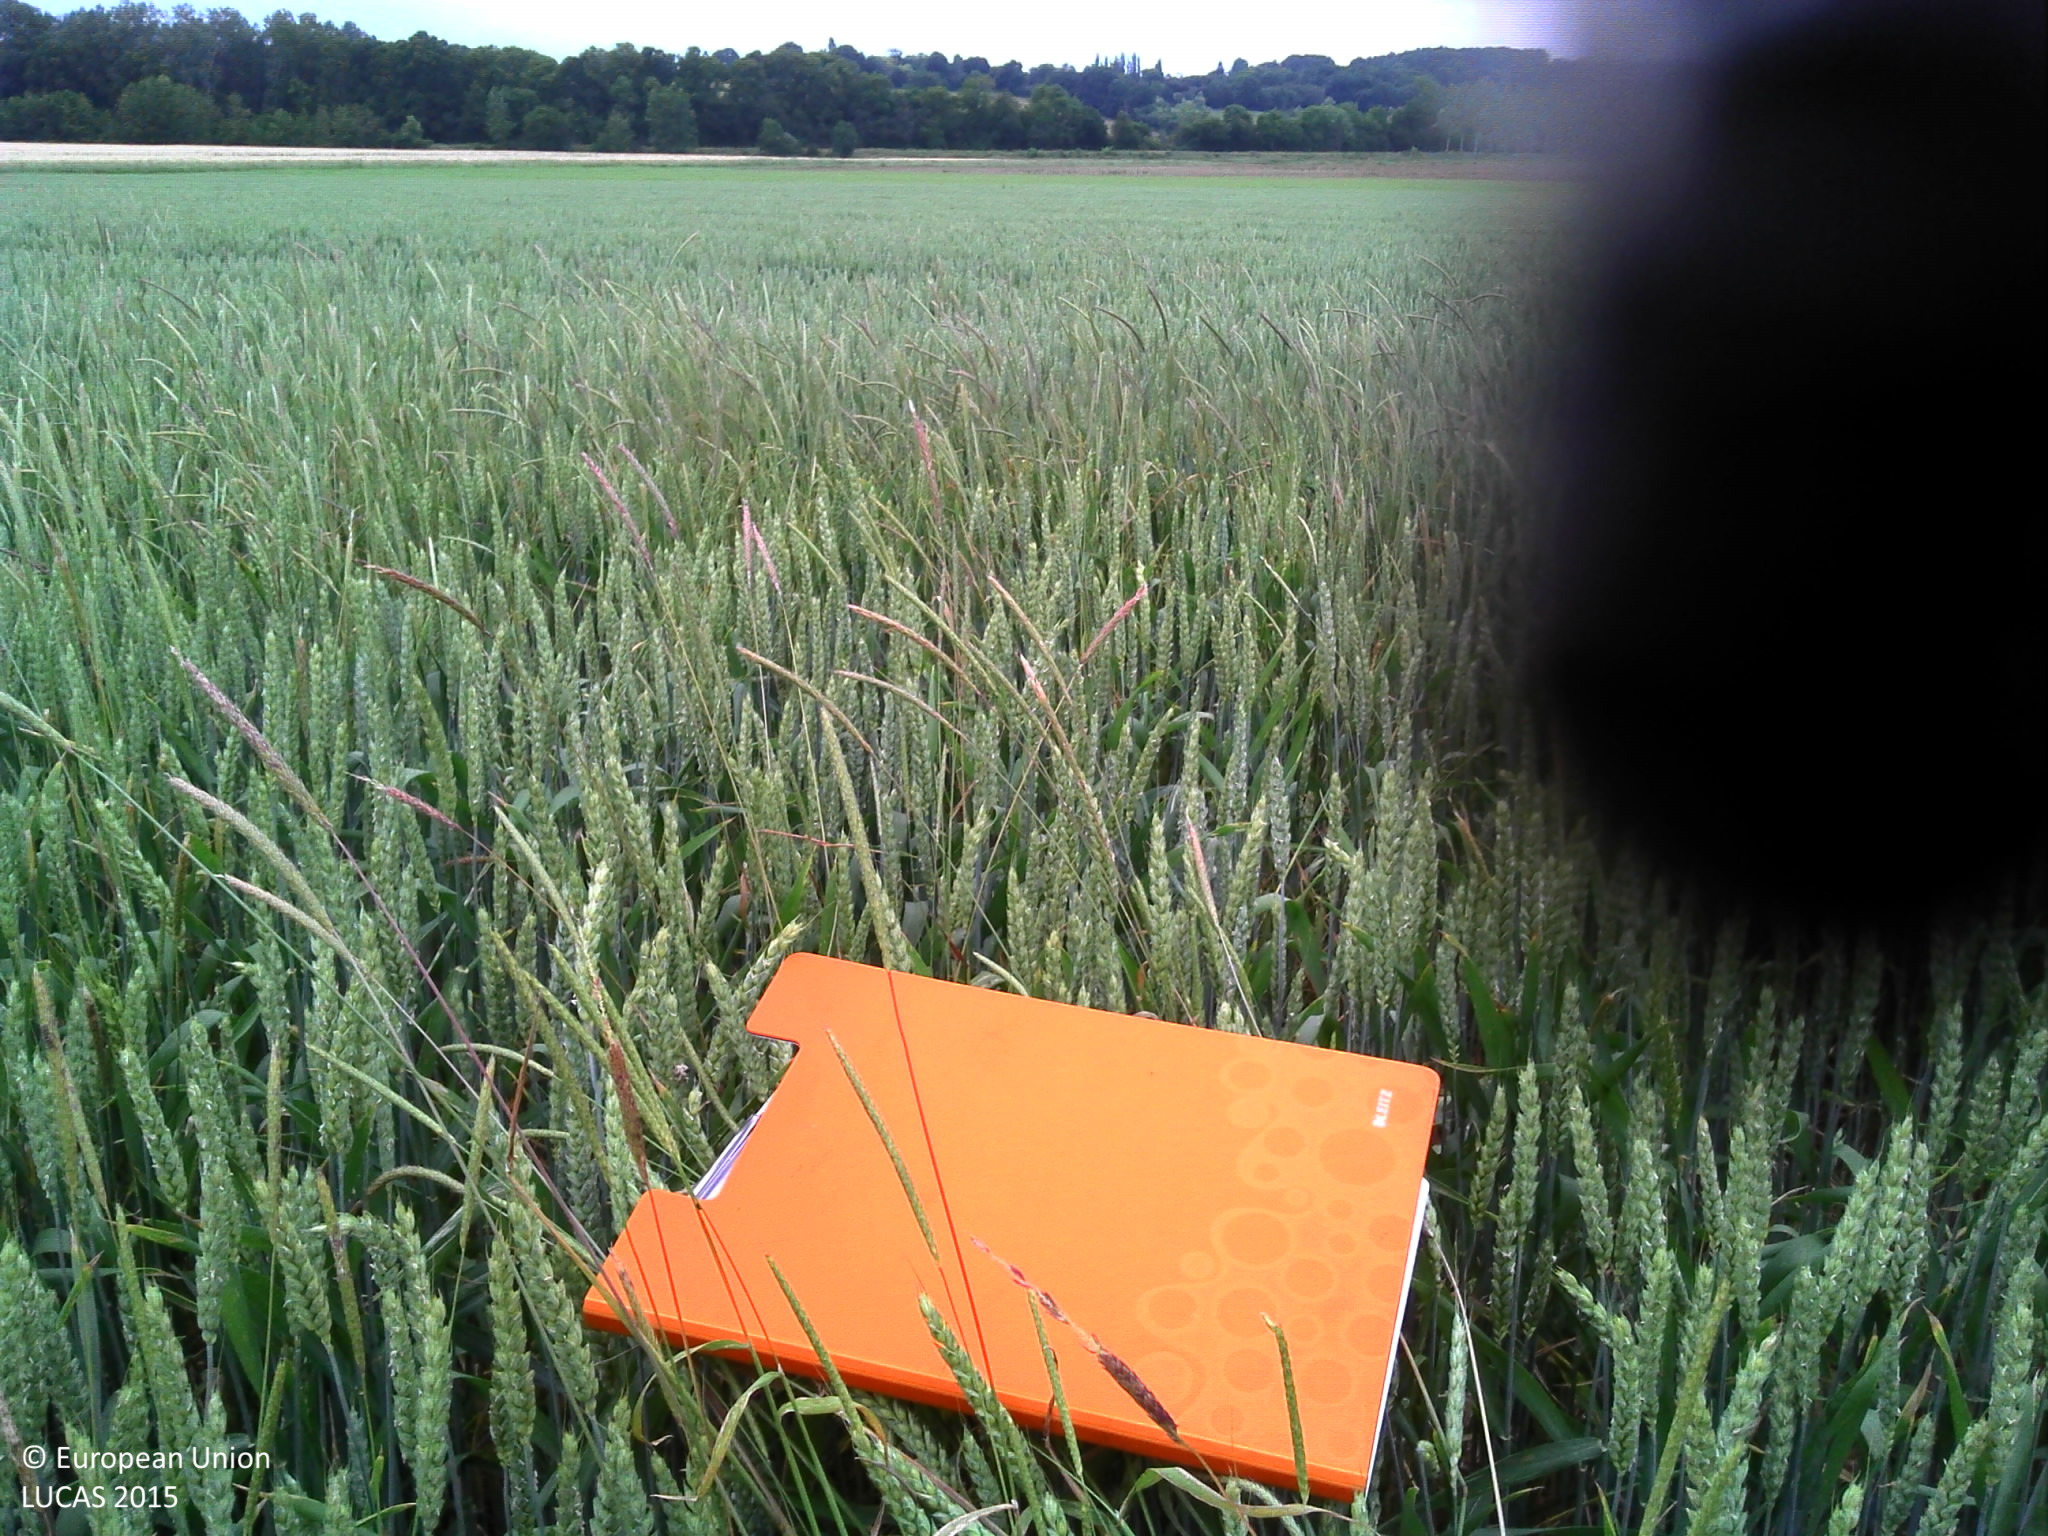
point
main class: Cropland
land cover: Common wheat
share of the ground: > 75 %
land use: Agriculture (excluding fallow land and kitchen gardens)
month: June
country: FR
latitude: 46.7885
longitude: 2.6985
